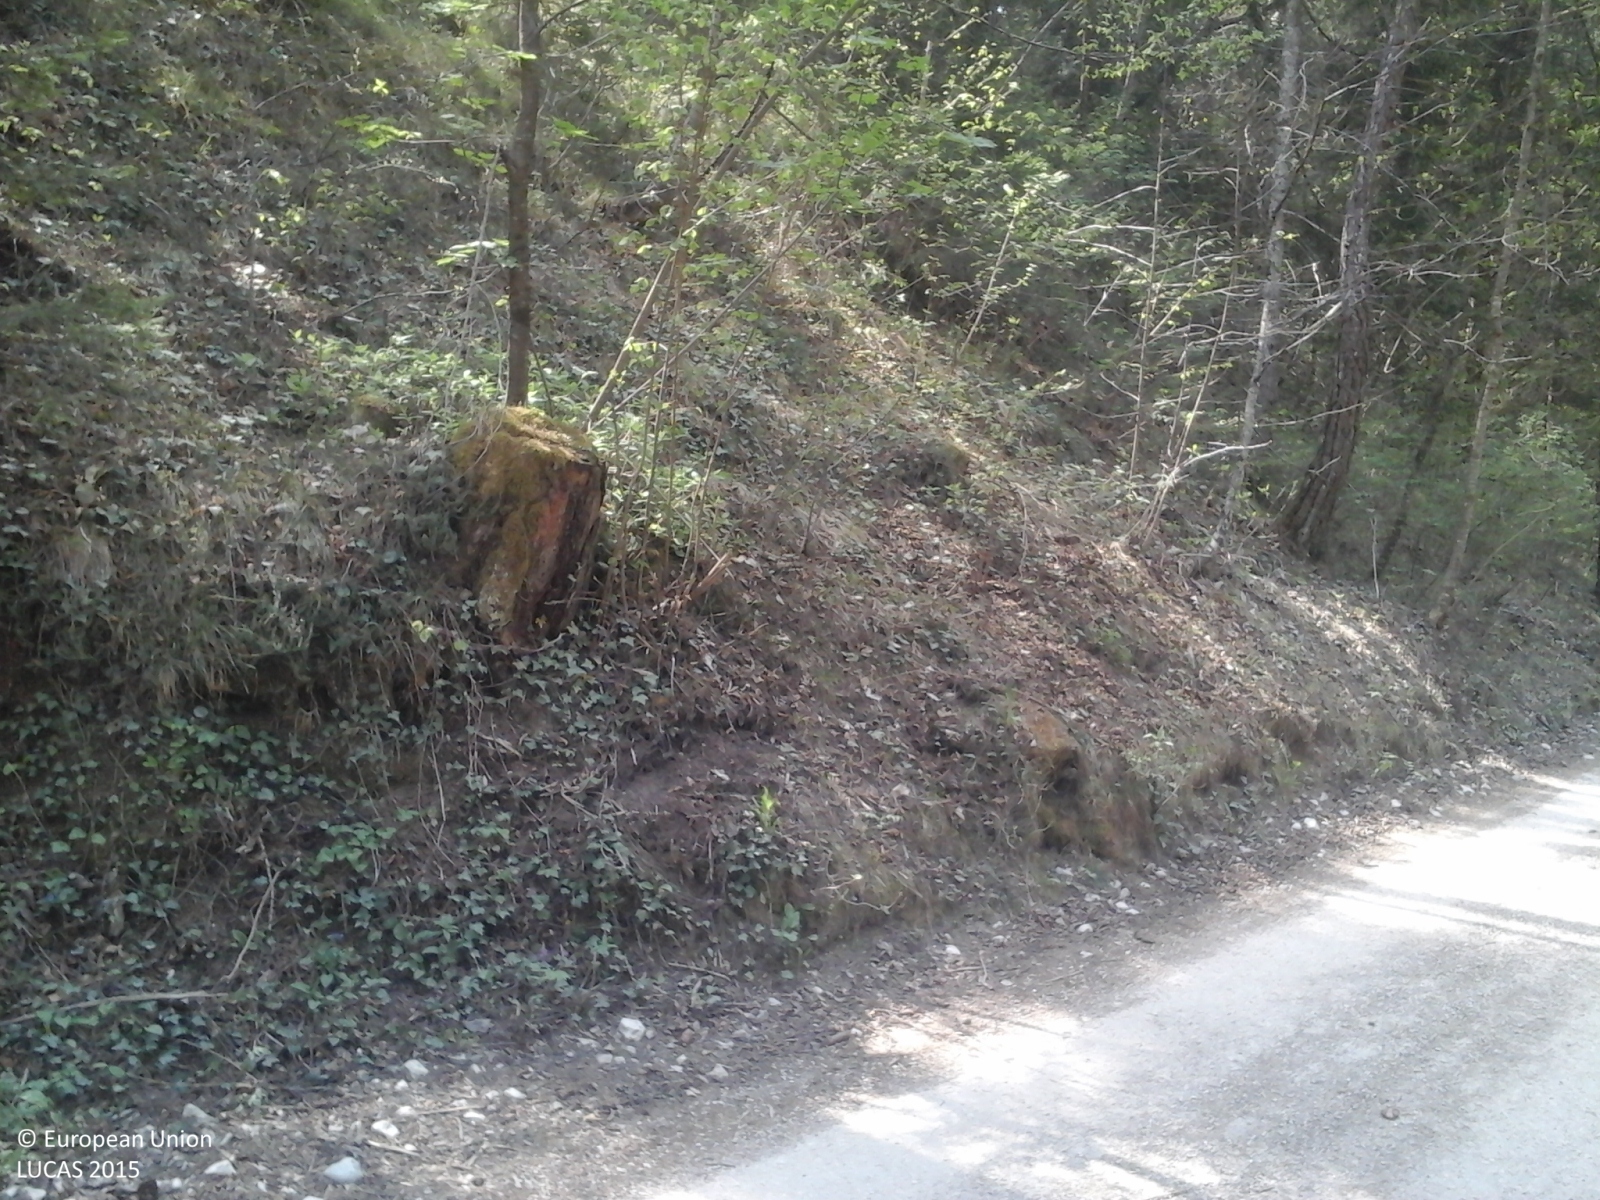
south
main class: Woodland
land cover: Other mixed woodland
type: mesophytic deciduous forest
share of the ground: > 75 %
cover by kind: coniferous forest trees 50 %, broadleaved forest trees 50 %
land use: Forestry
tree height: > 5 m
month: April
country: IT
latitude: 46.3635
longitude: 11.1034
